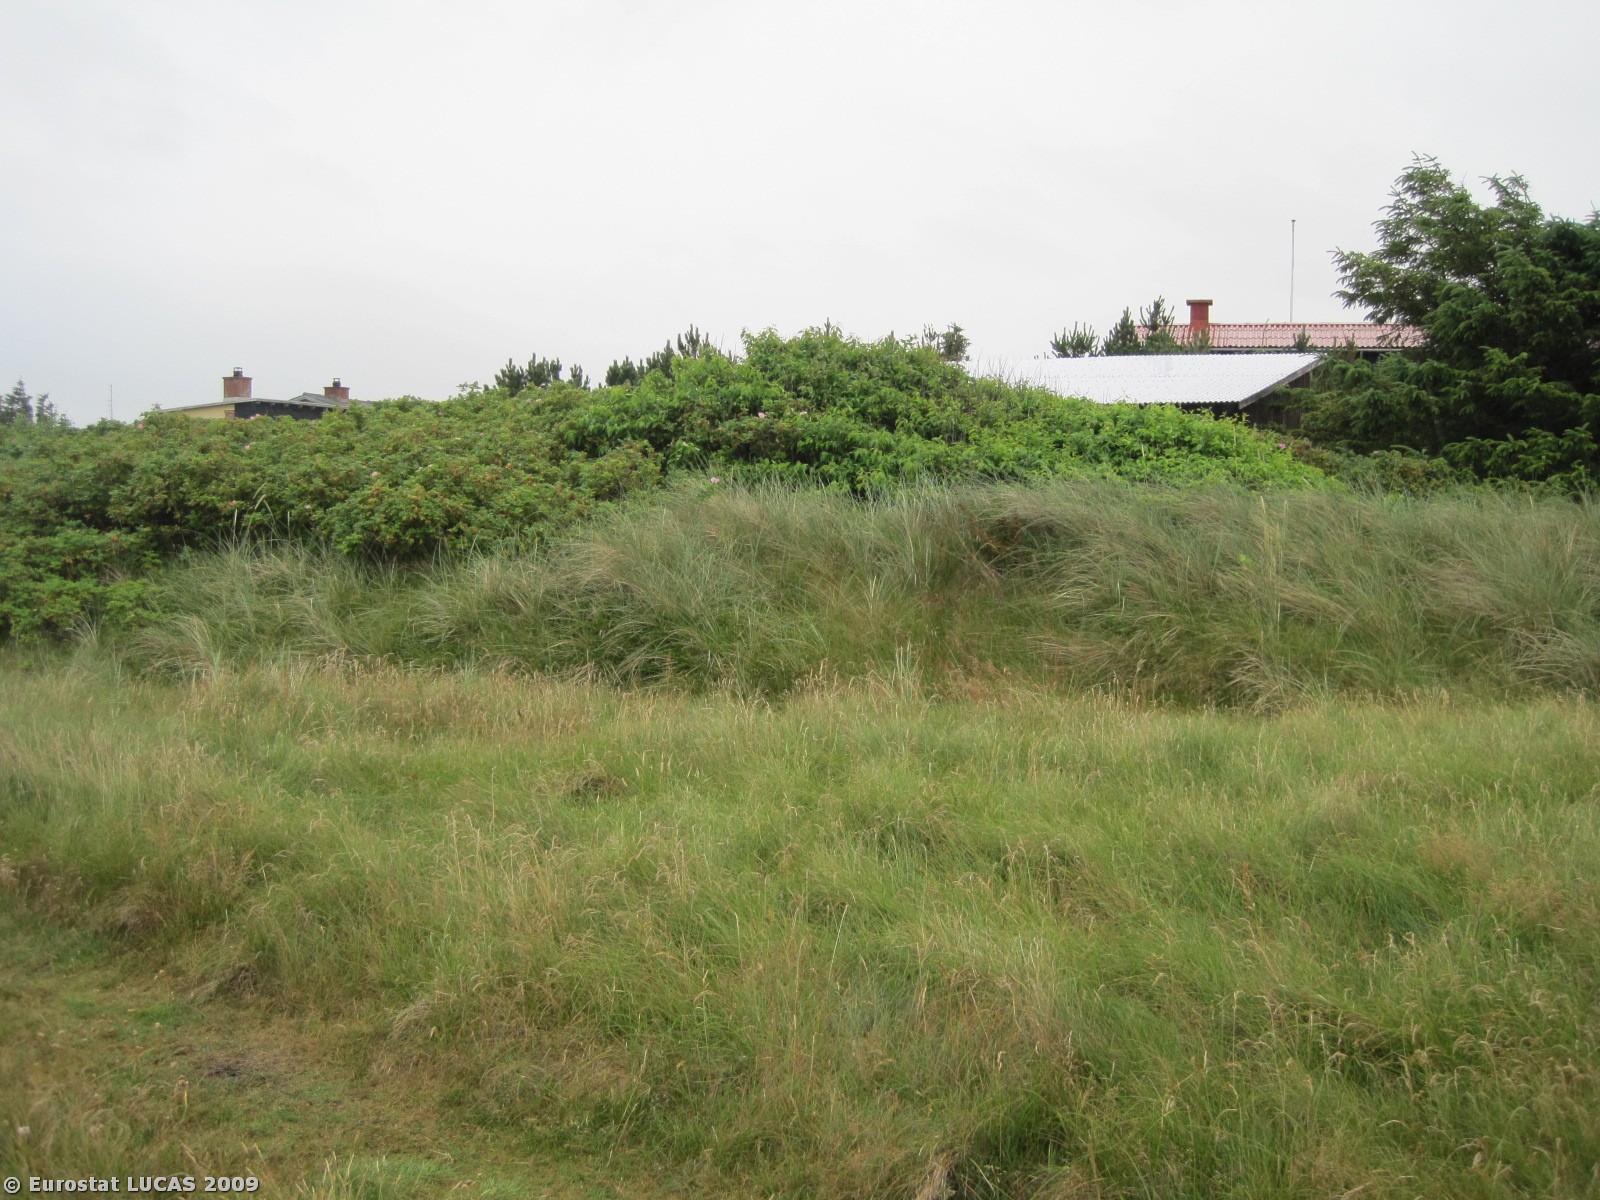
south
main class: Grassland
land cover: Grassland without tree/shrub cover
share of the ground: > 75 %
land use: Amenities, museums, leisure
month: July
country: DK
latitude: 57.0421
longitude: 8.5024
